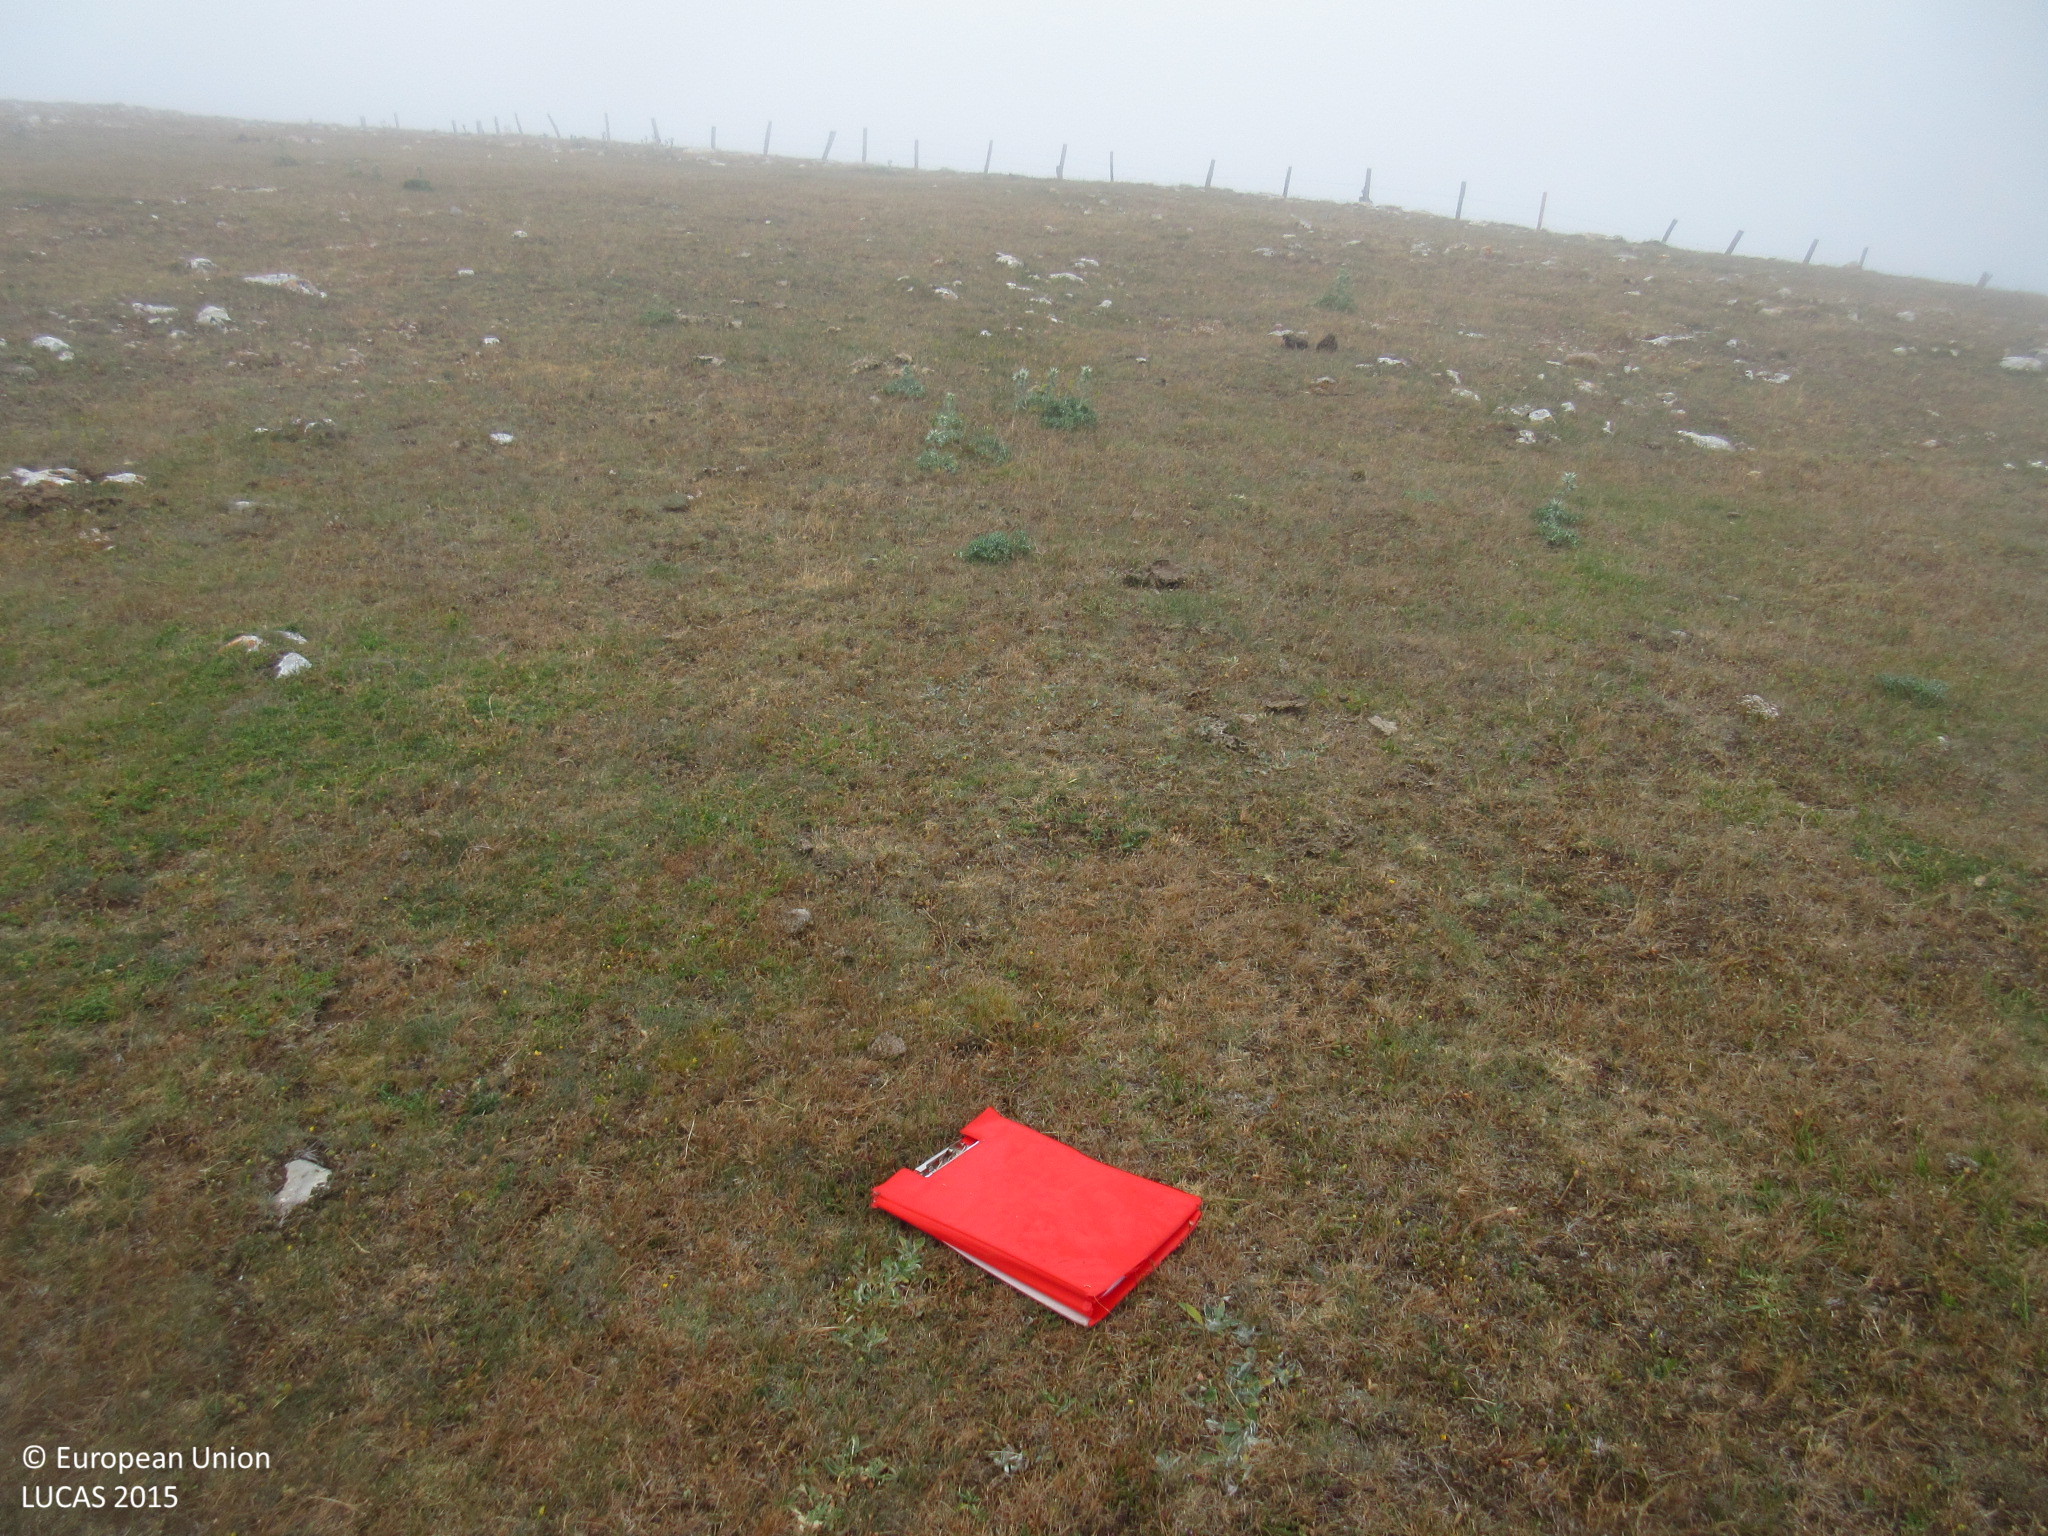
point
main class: Grassland
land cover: Grassland without tree/shrub cover
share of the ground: > 75 %
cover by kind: herbaceous plants 100 %
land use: Agriculture (excluding fallow land and kitchen gardens)
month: July
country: ES
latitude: 43.0266
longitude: -4.0264
